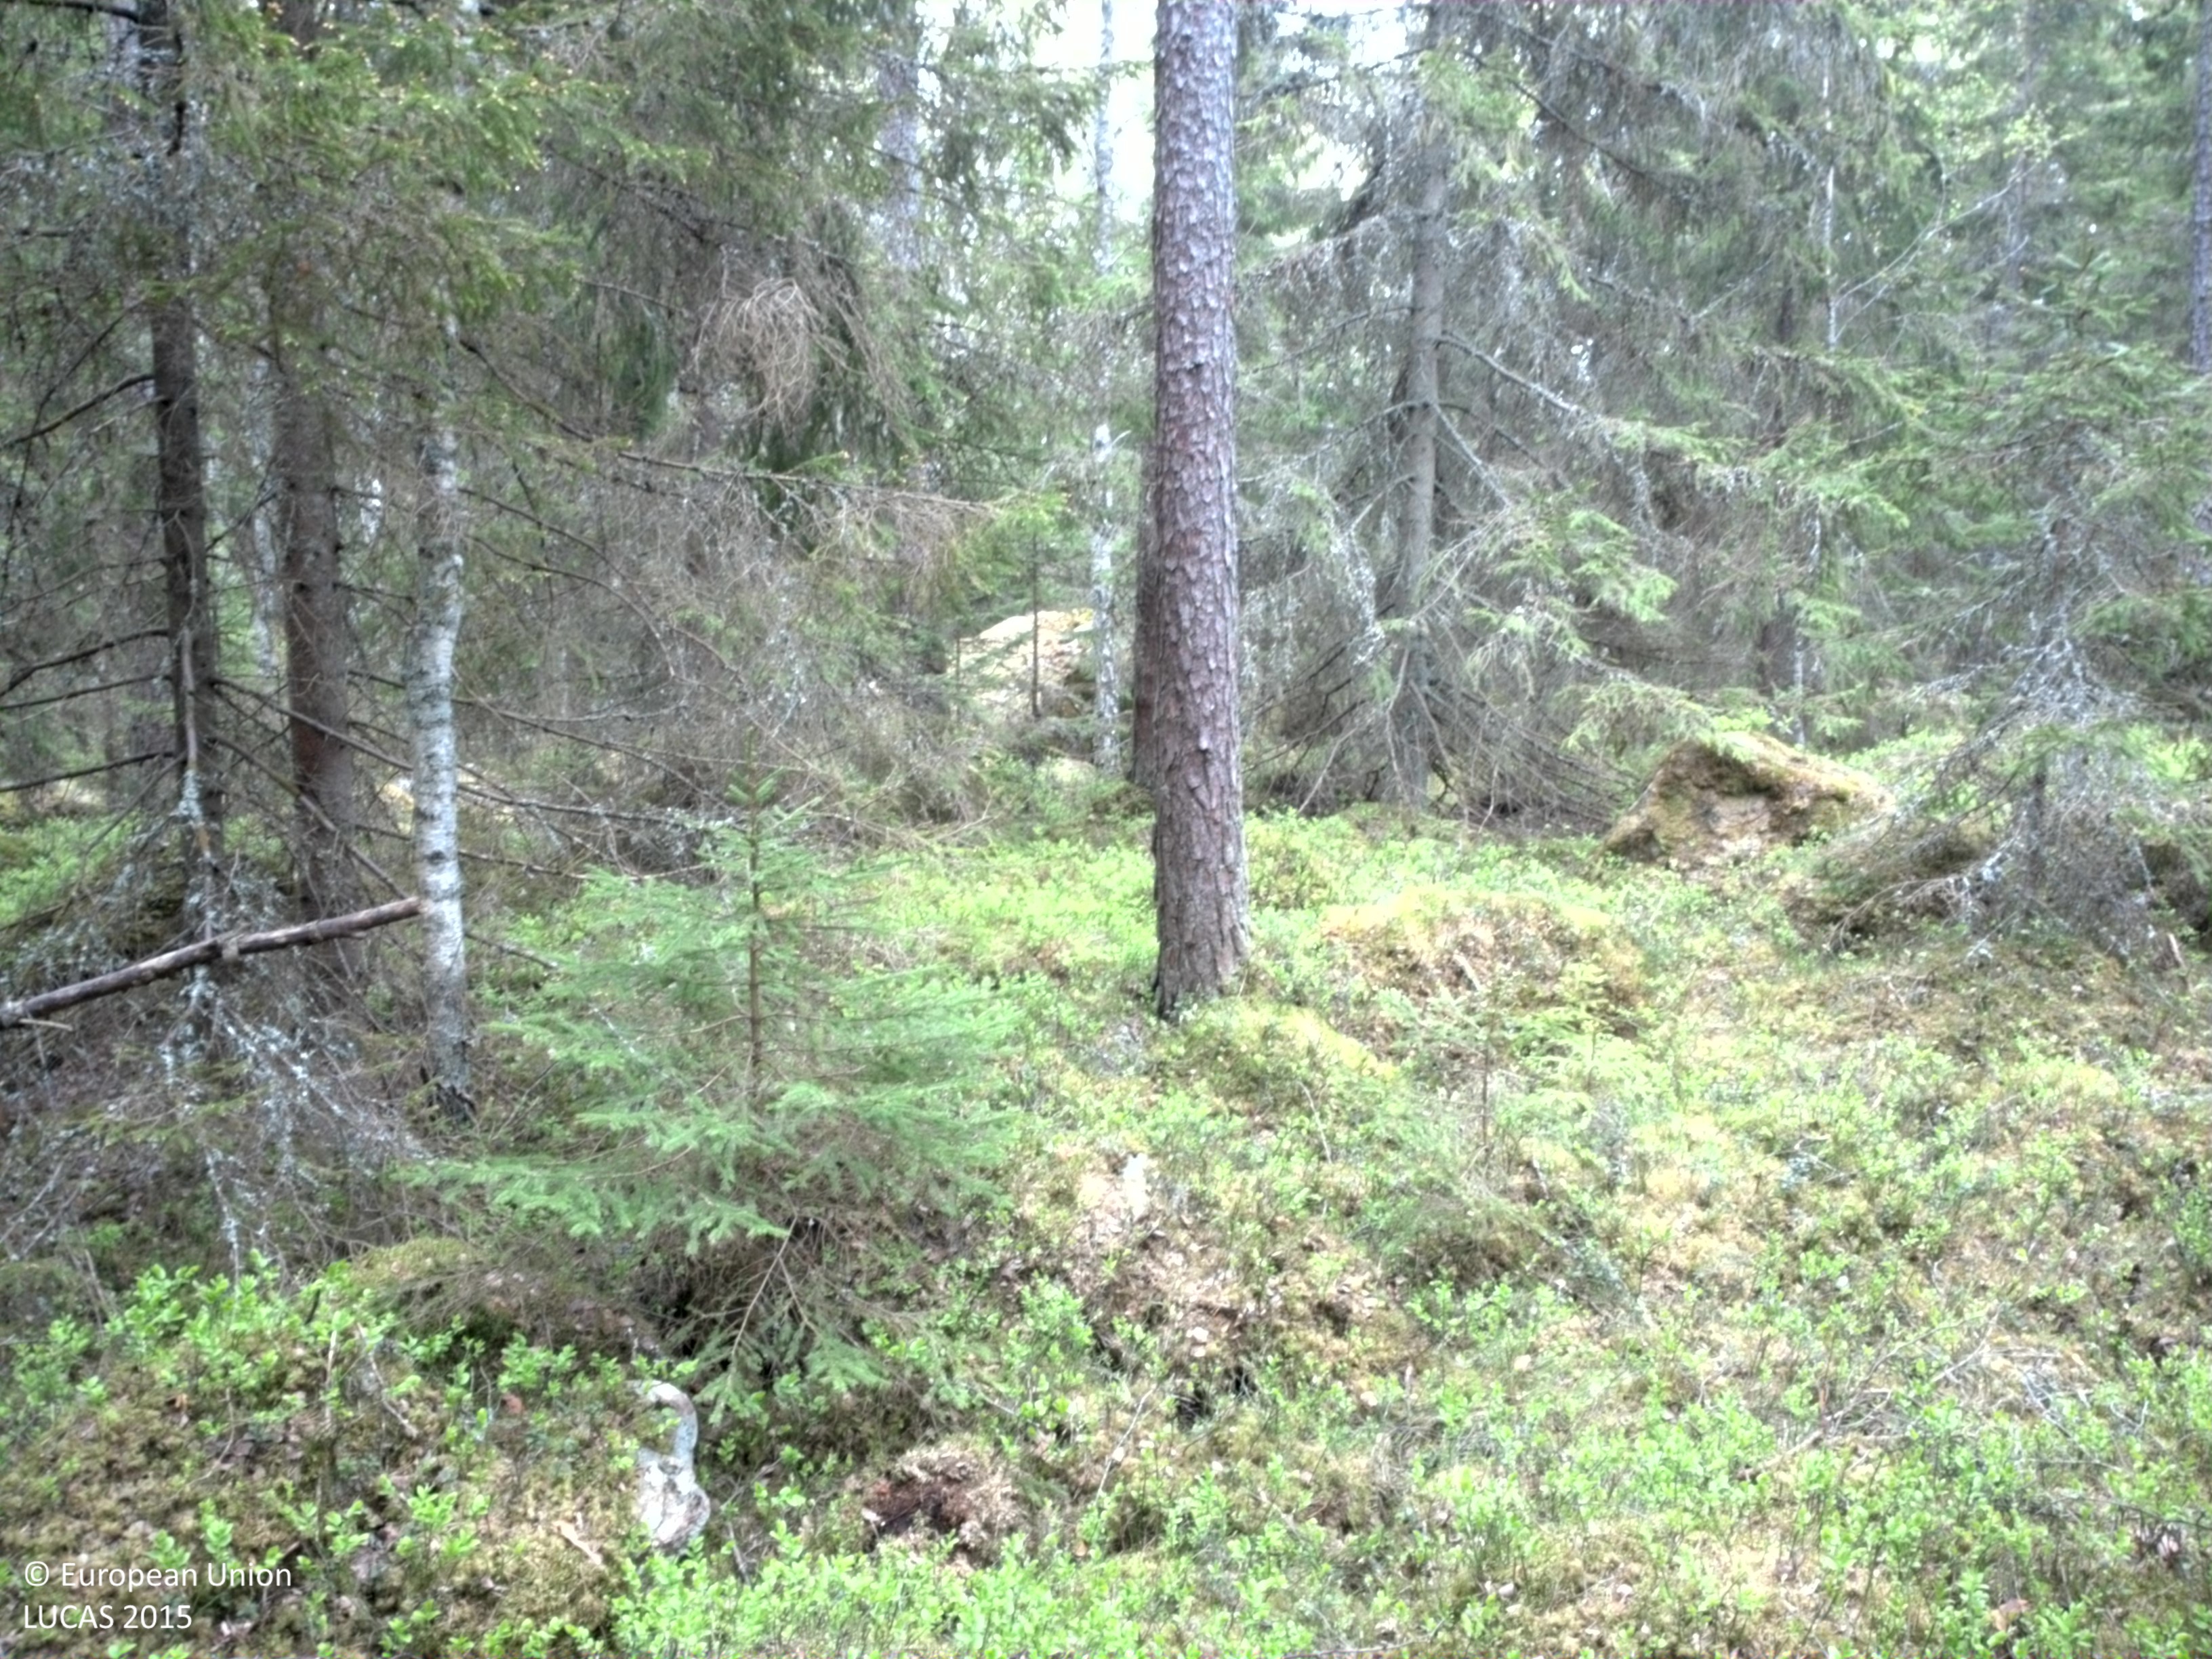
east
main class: Woodland
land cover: Spruce dominated mixed woodland
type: boreal forest
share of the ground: 50 - 75 %
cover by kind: coniferous forest trees 50 %, broadleaved forest trees 25 %, shrubs 15 %, lichens and mosses 10 %
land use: Forestry
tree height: > 5 m
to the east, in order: Spruce dominated mixed woodland; Ditches and canals; Spruce dominated mixed woodland; Electric lines; Spruce dominated mixed woodland; Grass margins; Paved roads, cycling and walking lanes; Grassland without tree/shrub cover; Grassland with sparse tree/shrub cover
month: May
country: SE
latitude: 56.7034
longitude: 15.4373
